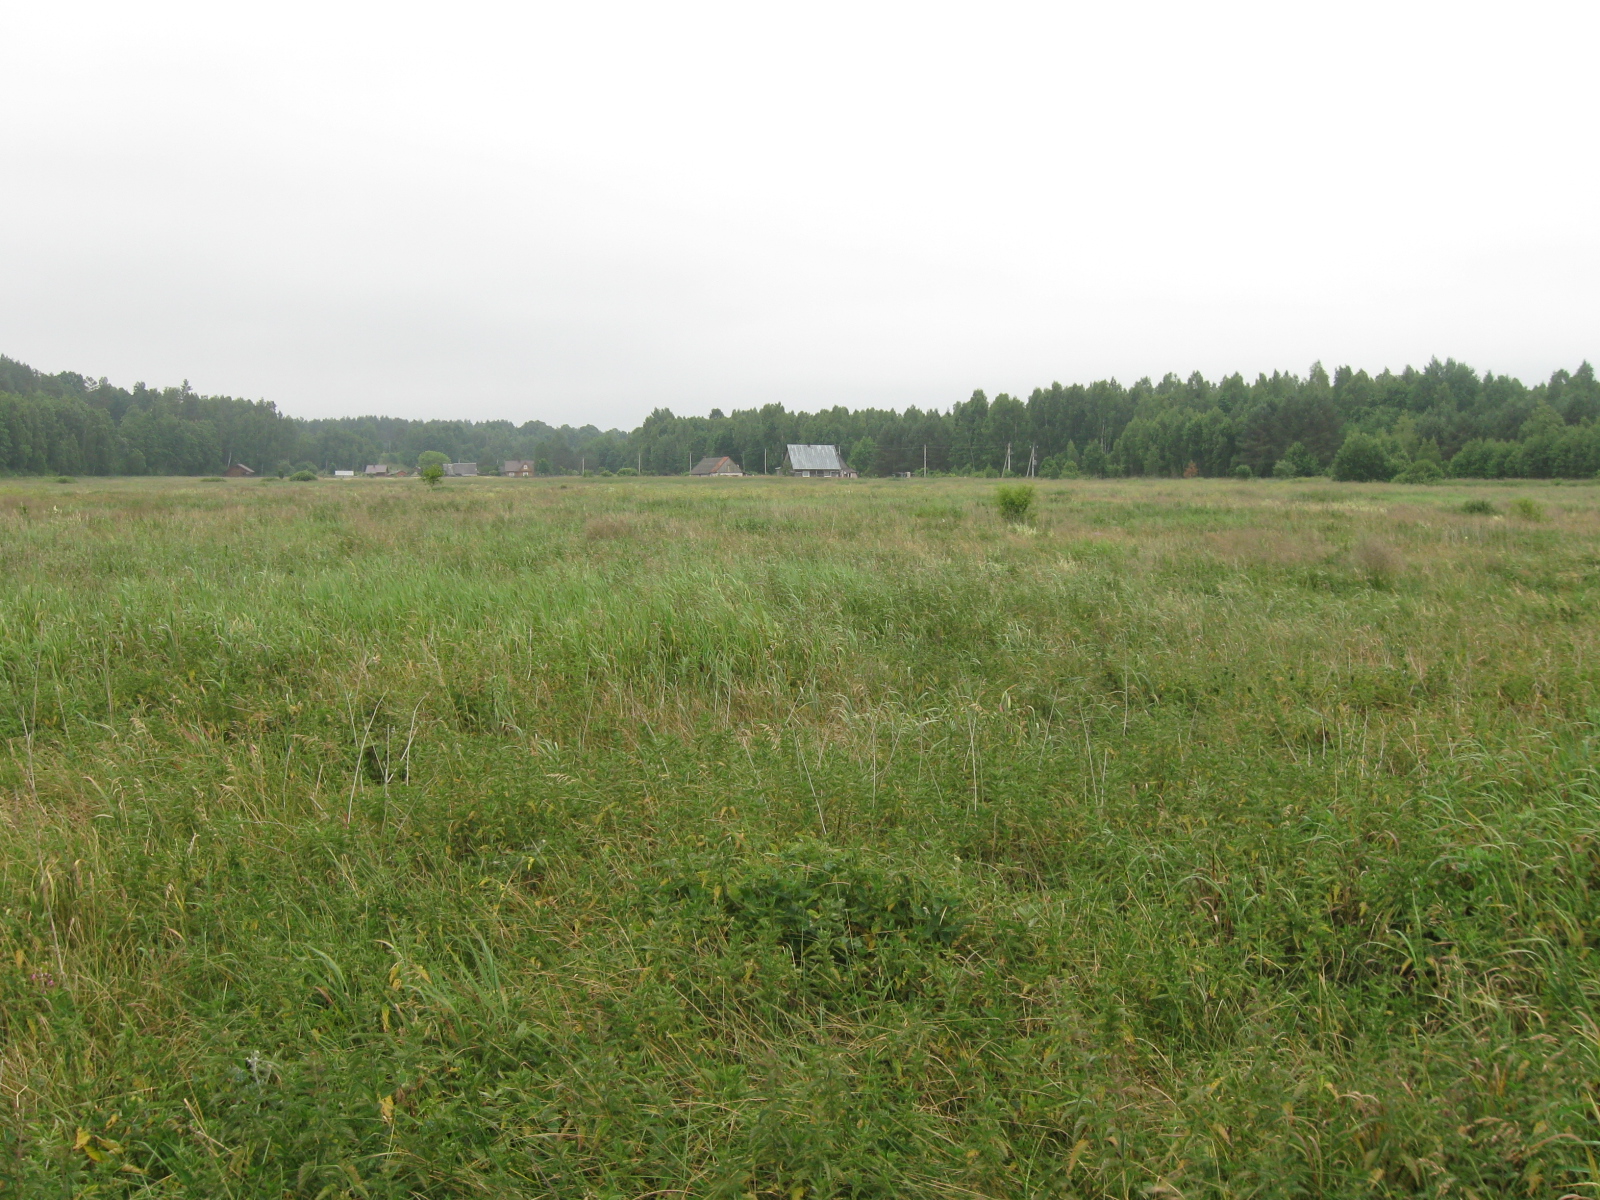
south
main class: Grassland
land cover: Spontaneously vegetated surfaces
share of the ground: > 75 %
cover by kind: herbaceous plants 100 %
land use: Abandoned areas
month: July
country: LT
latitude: 54.0791
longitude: 24.1738
